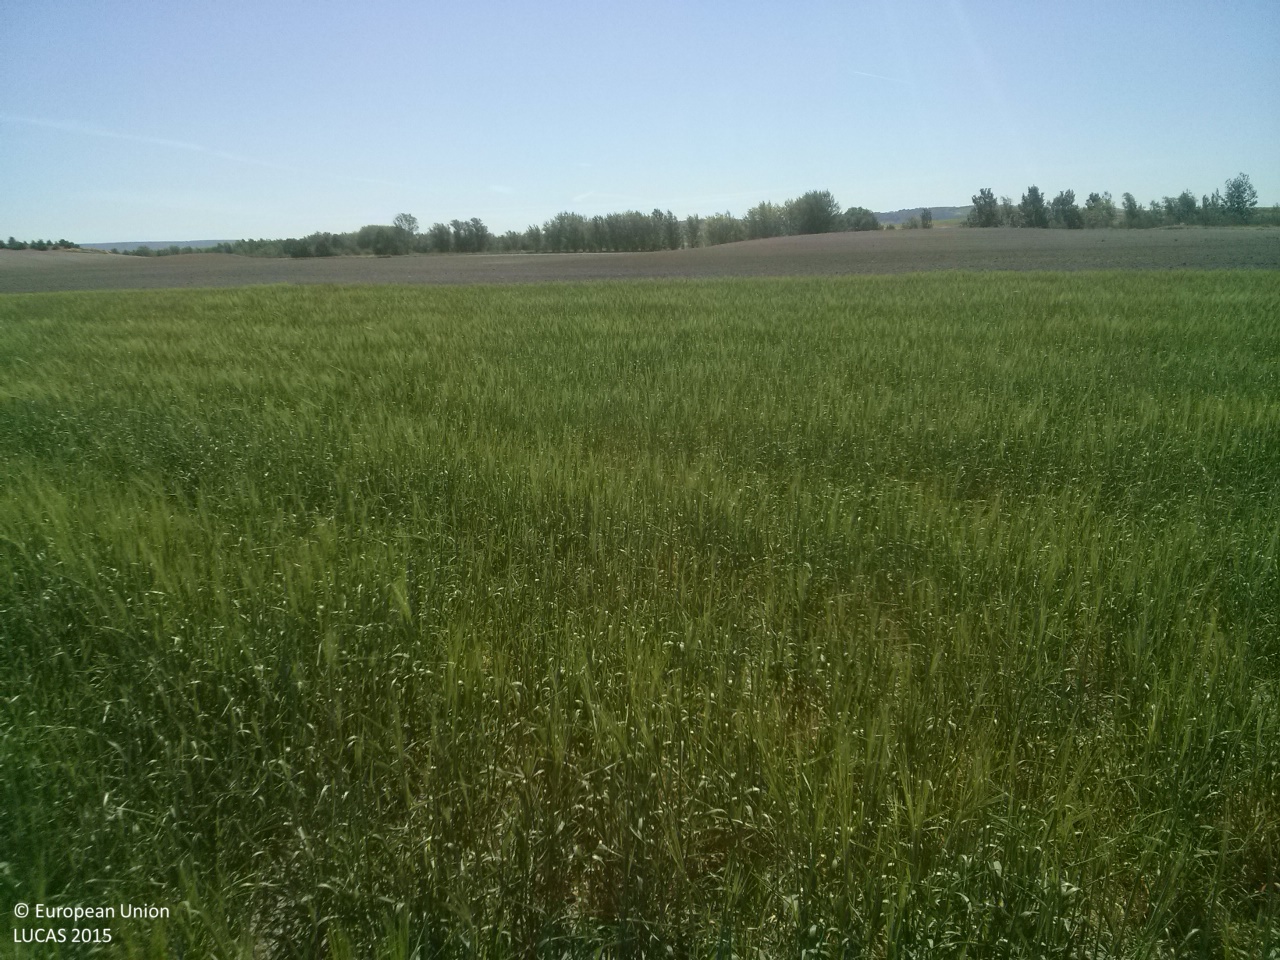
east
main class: Cropland
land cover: Barley
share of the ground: > 75 %
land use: Agriculture (excluding fallow land and kitchen gardens)
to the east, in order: Barley; Other bare soil
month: May
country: ES
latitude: 39.9510
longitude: -2.6962
